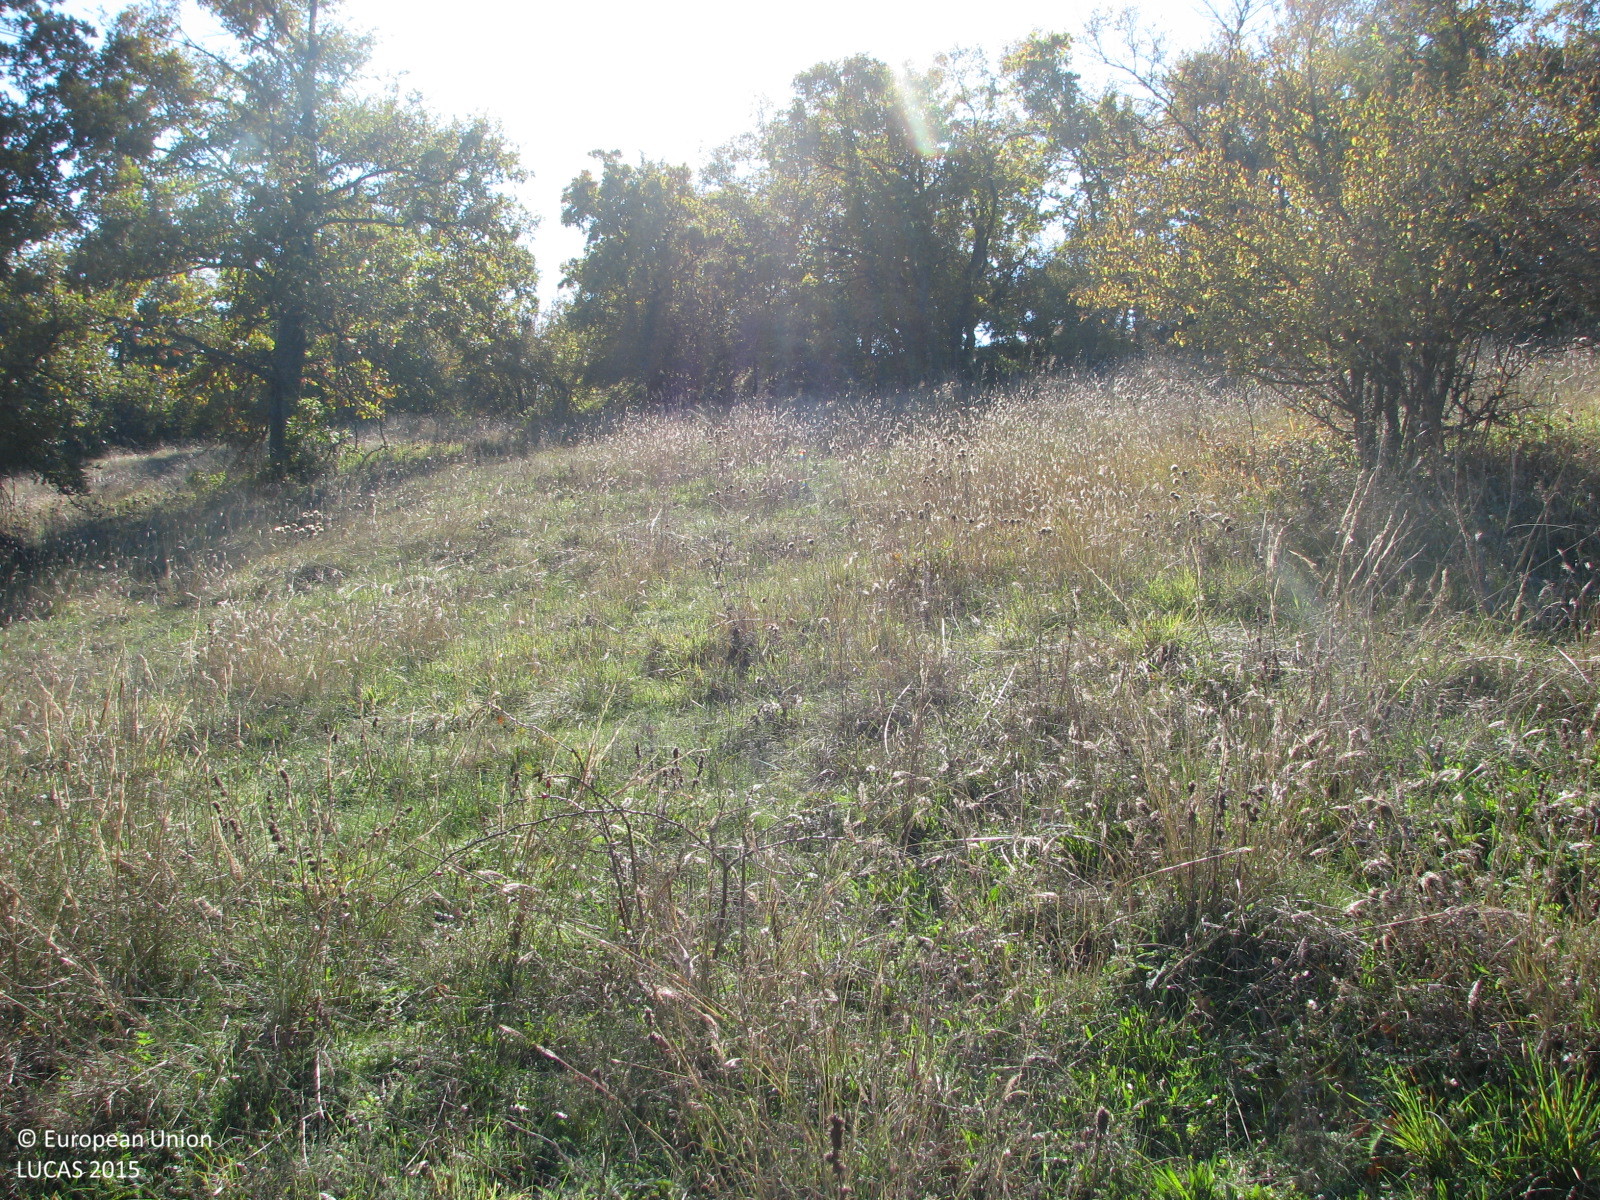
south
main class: Grassland
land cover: Grassland with sparse tree/shrub cover
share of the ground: > 75 %
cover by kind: herbaceous plants 85 %, shrubs 10 %, broadleaved forest trees 5 %
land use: Semi-natural and natural areas not in use
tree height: < 5 m
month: November
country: BG
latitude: 42.0594
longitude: 26.9547
